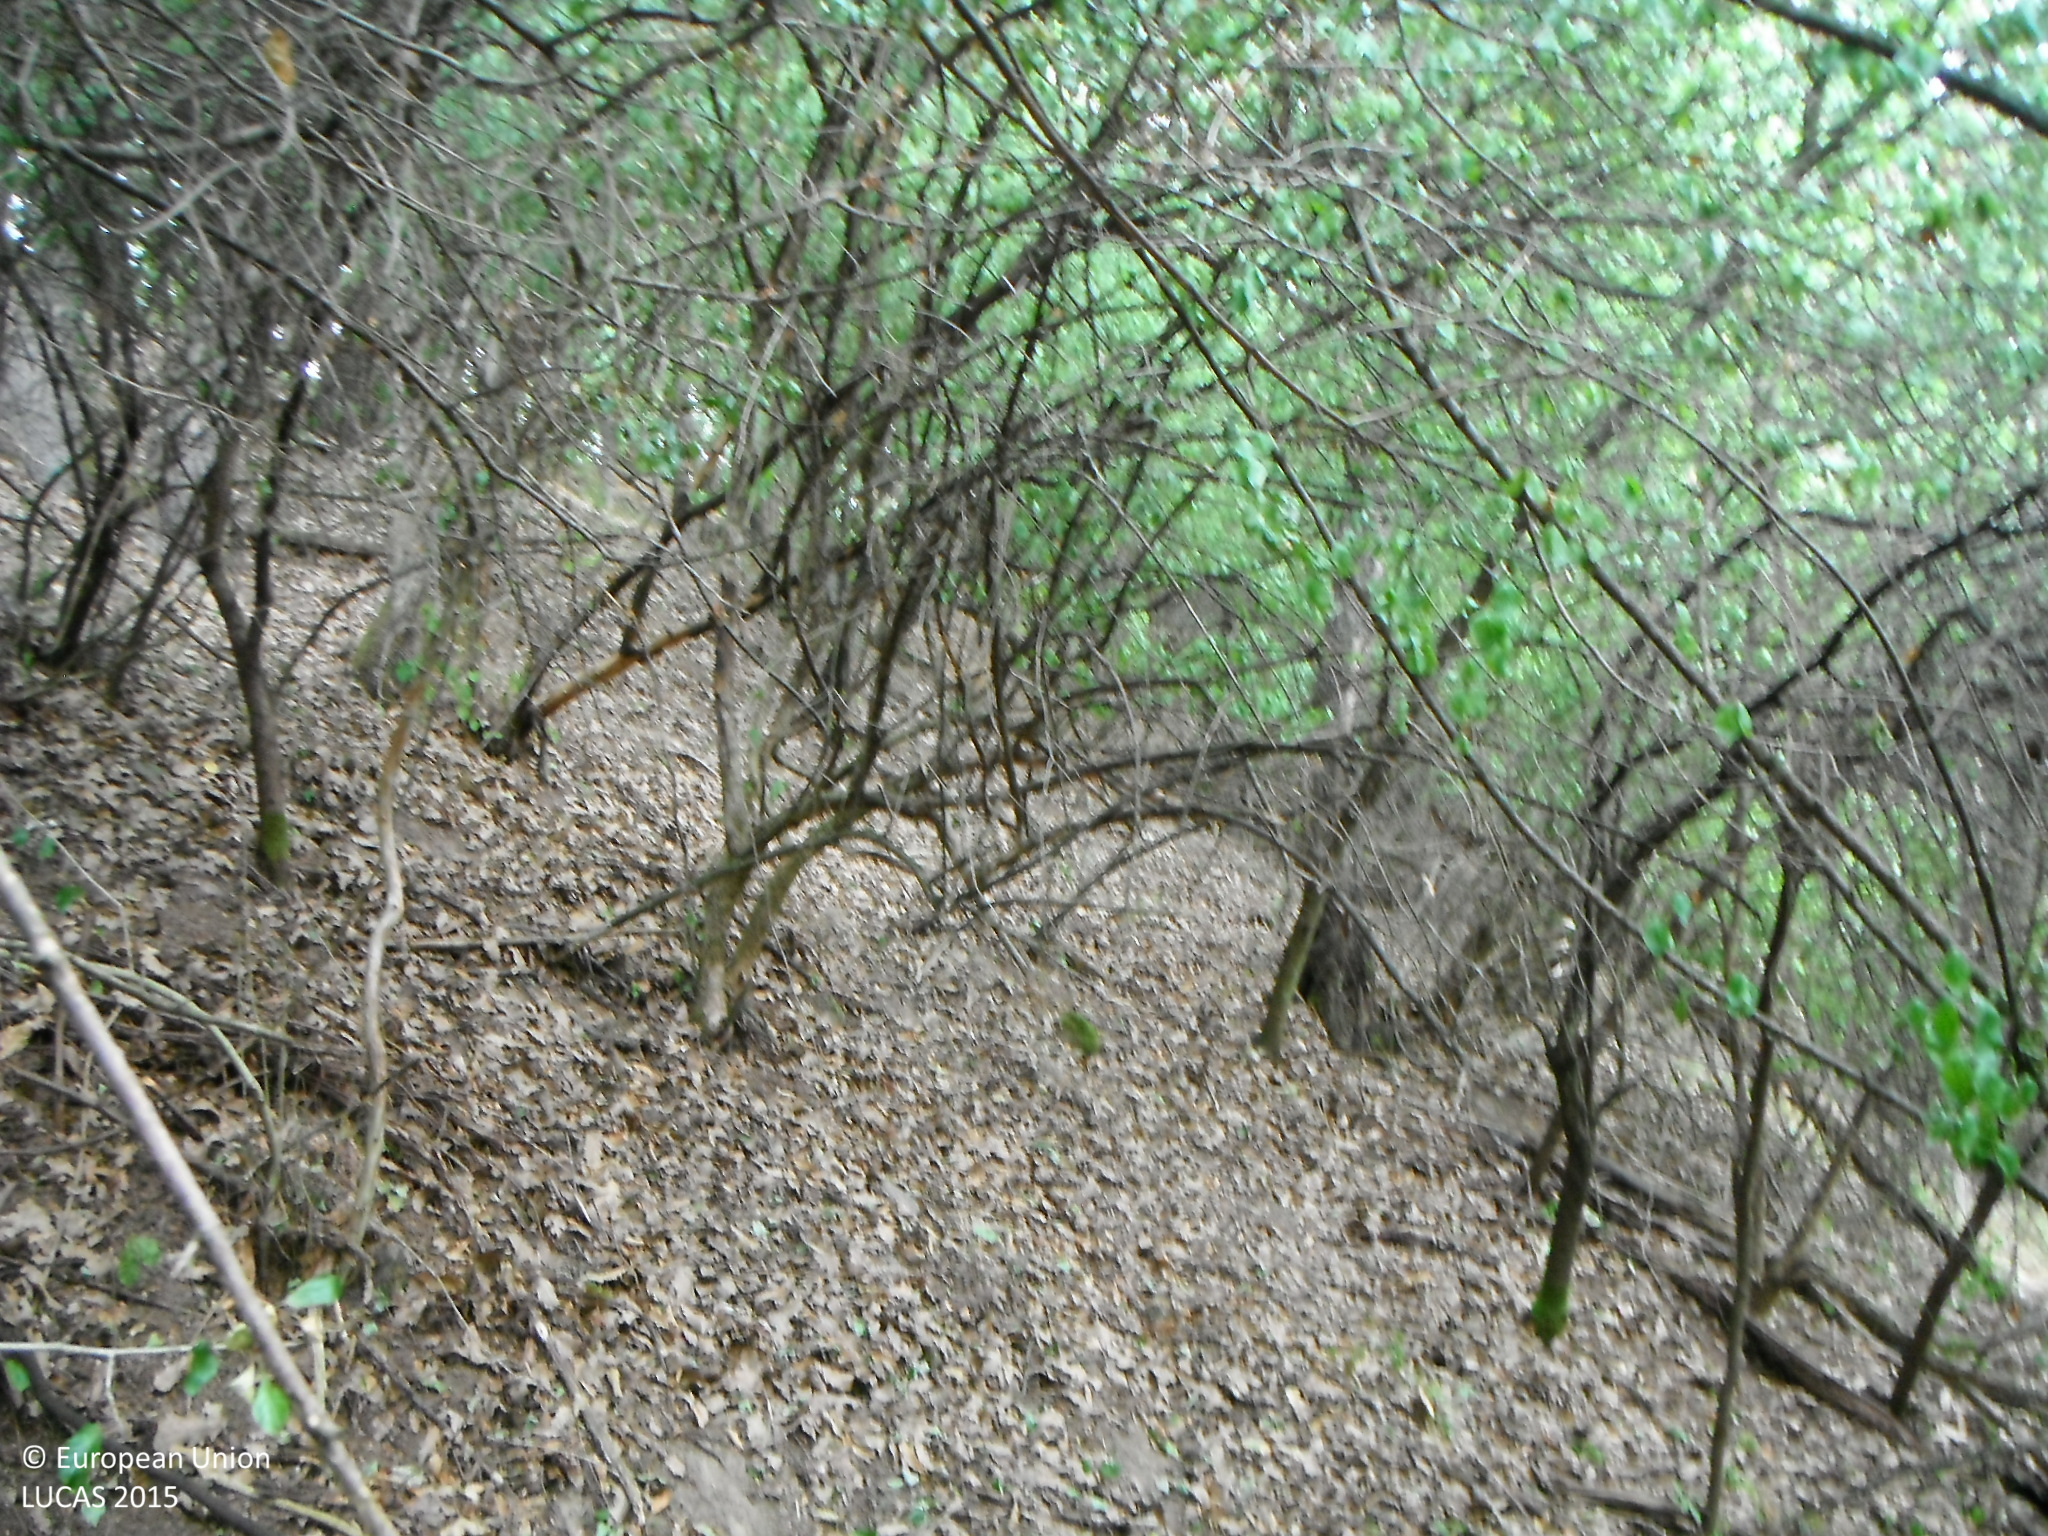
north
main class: Woodland
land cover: Broadleaved woodland
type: mesophytic deciduous forest
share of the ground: > 75 %
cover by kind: broadleaved forest trees 100 %
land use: Forestry
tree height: > 5 m
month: July
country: SK
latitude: 48.2841
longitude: 19.0633
